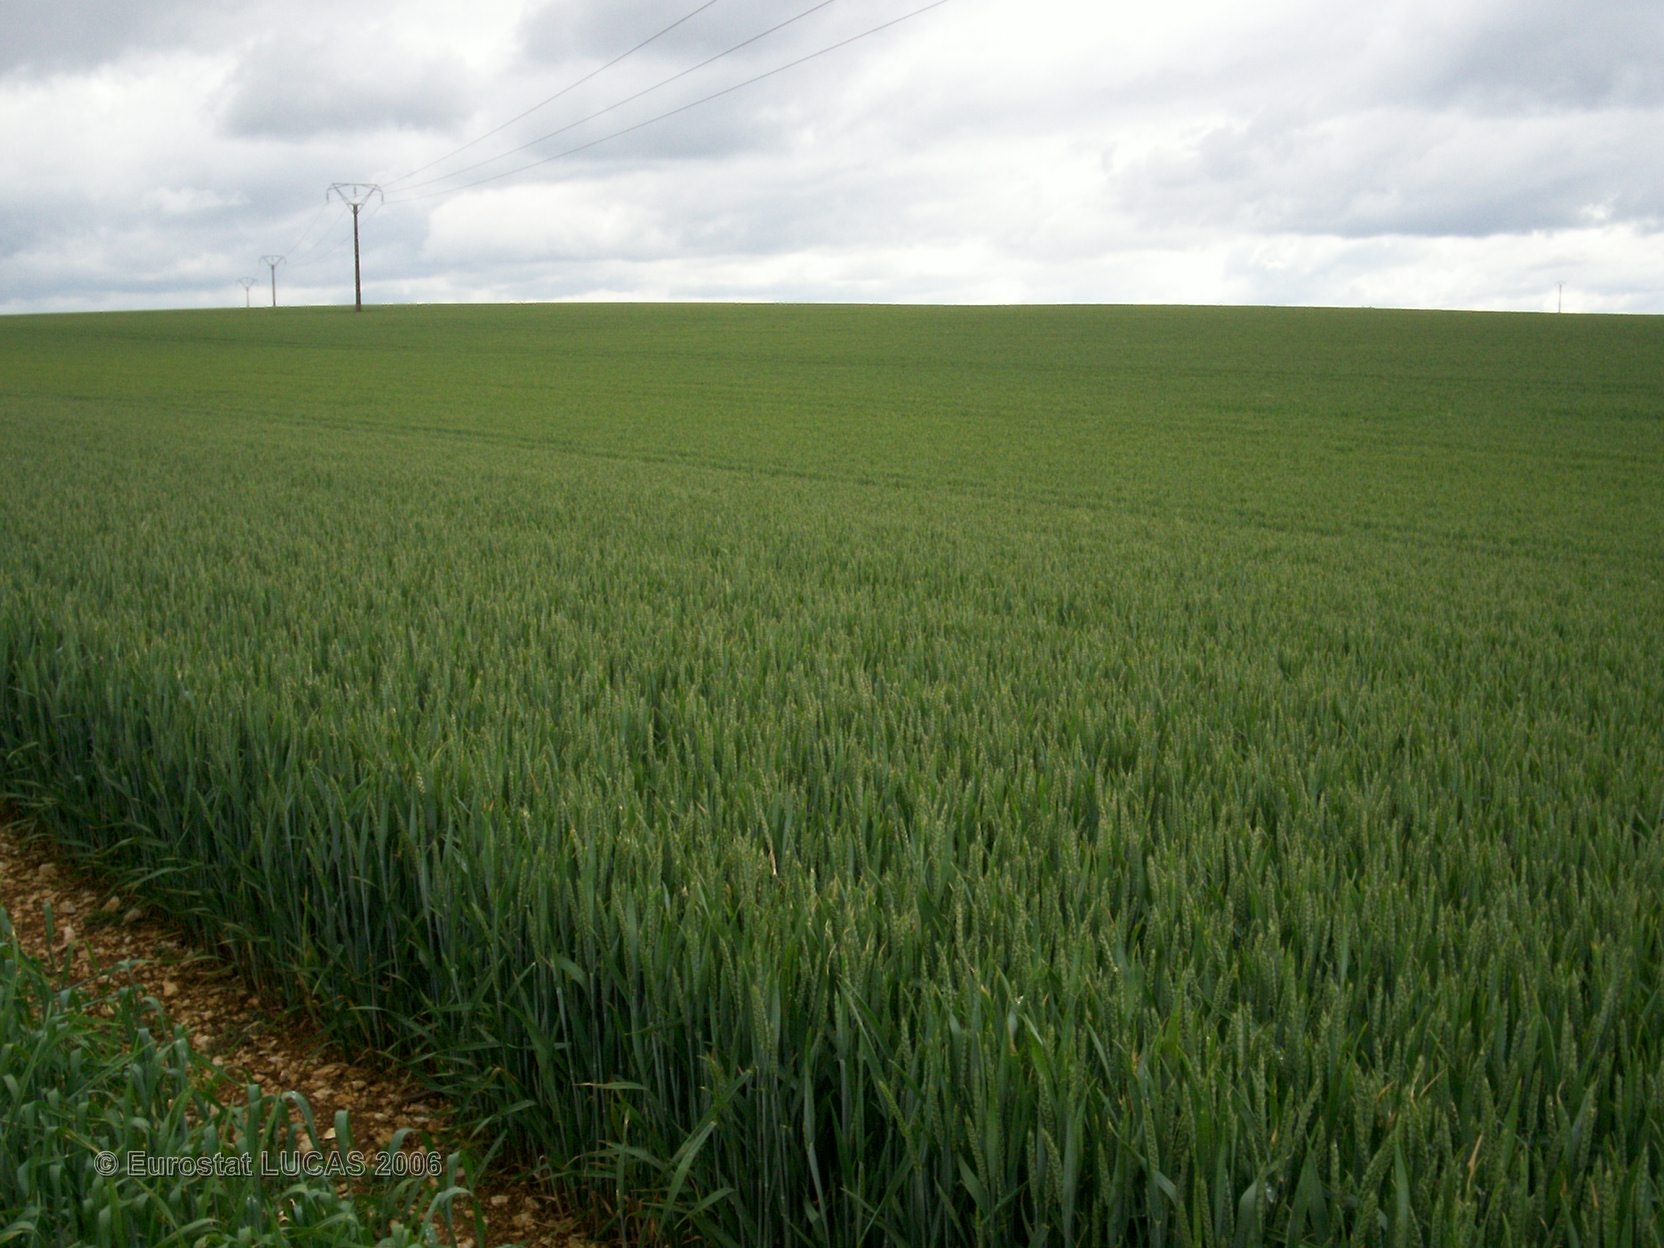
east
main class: Cropland
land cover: Common wheat
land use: Agriculture (excluding fallow land and kitchen gardens)
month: May
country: FR
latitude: 48.2507
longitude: 4.5432
